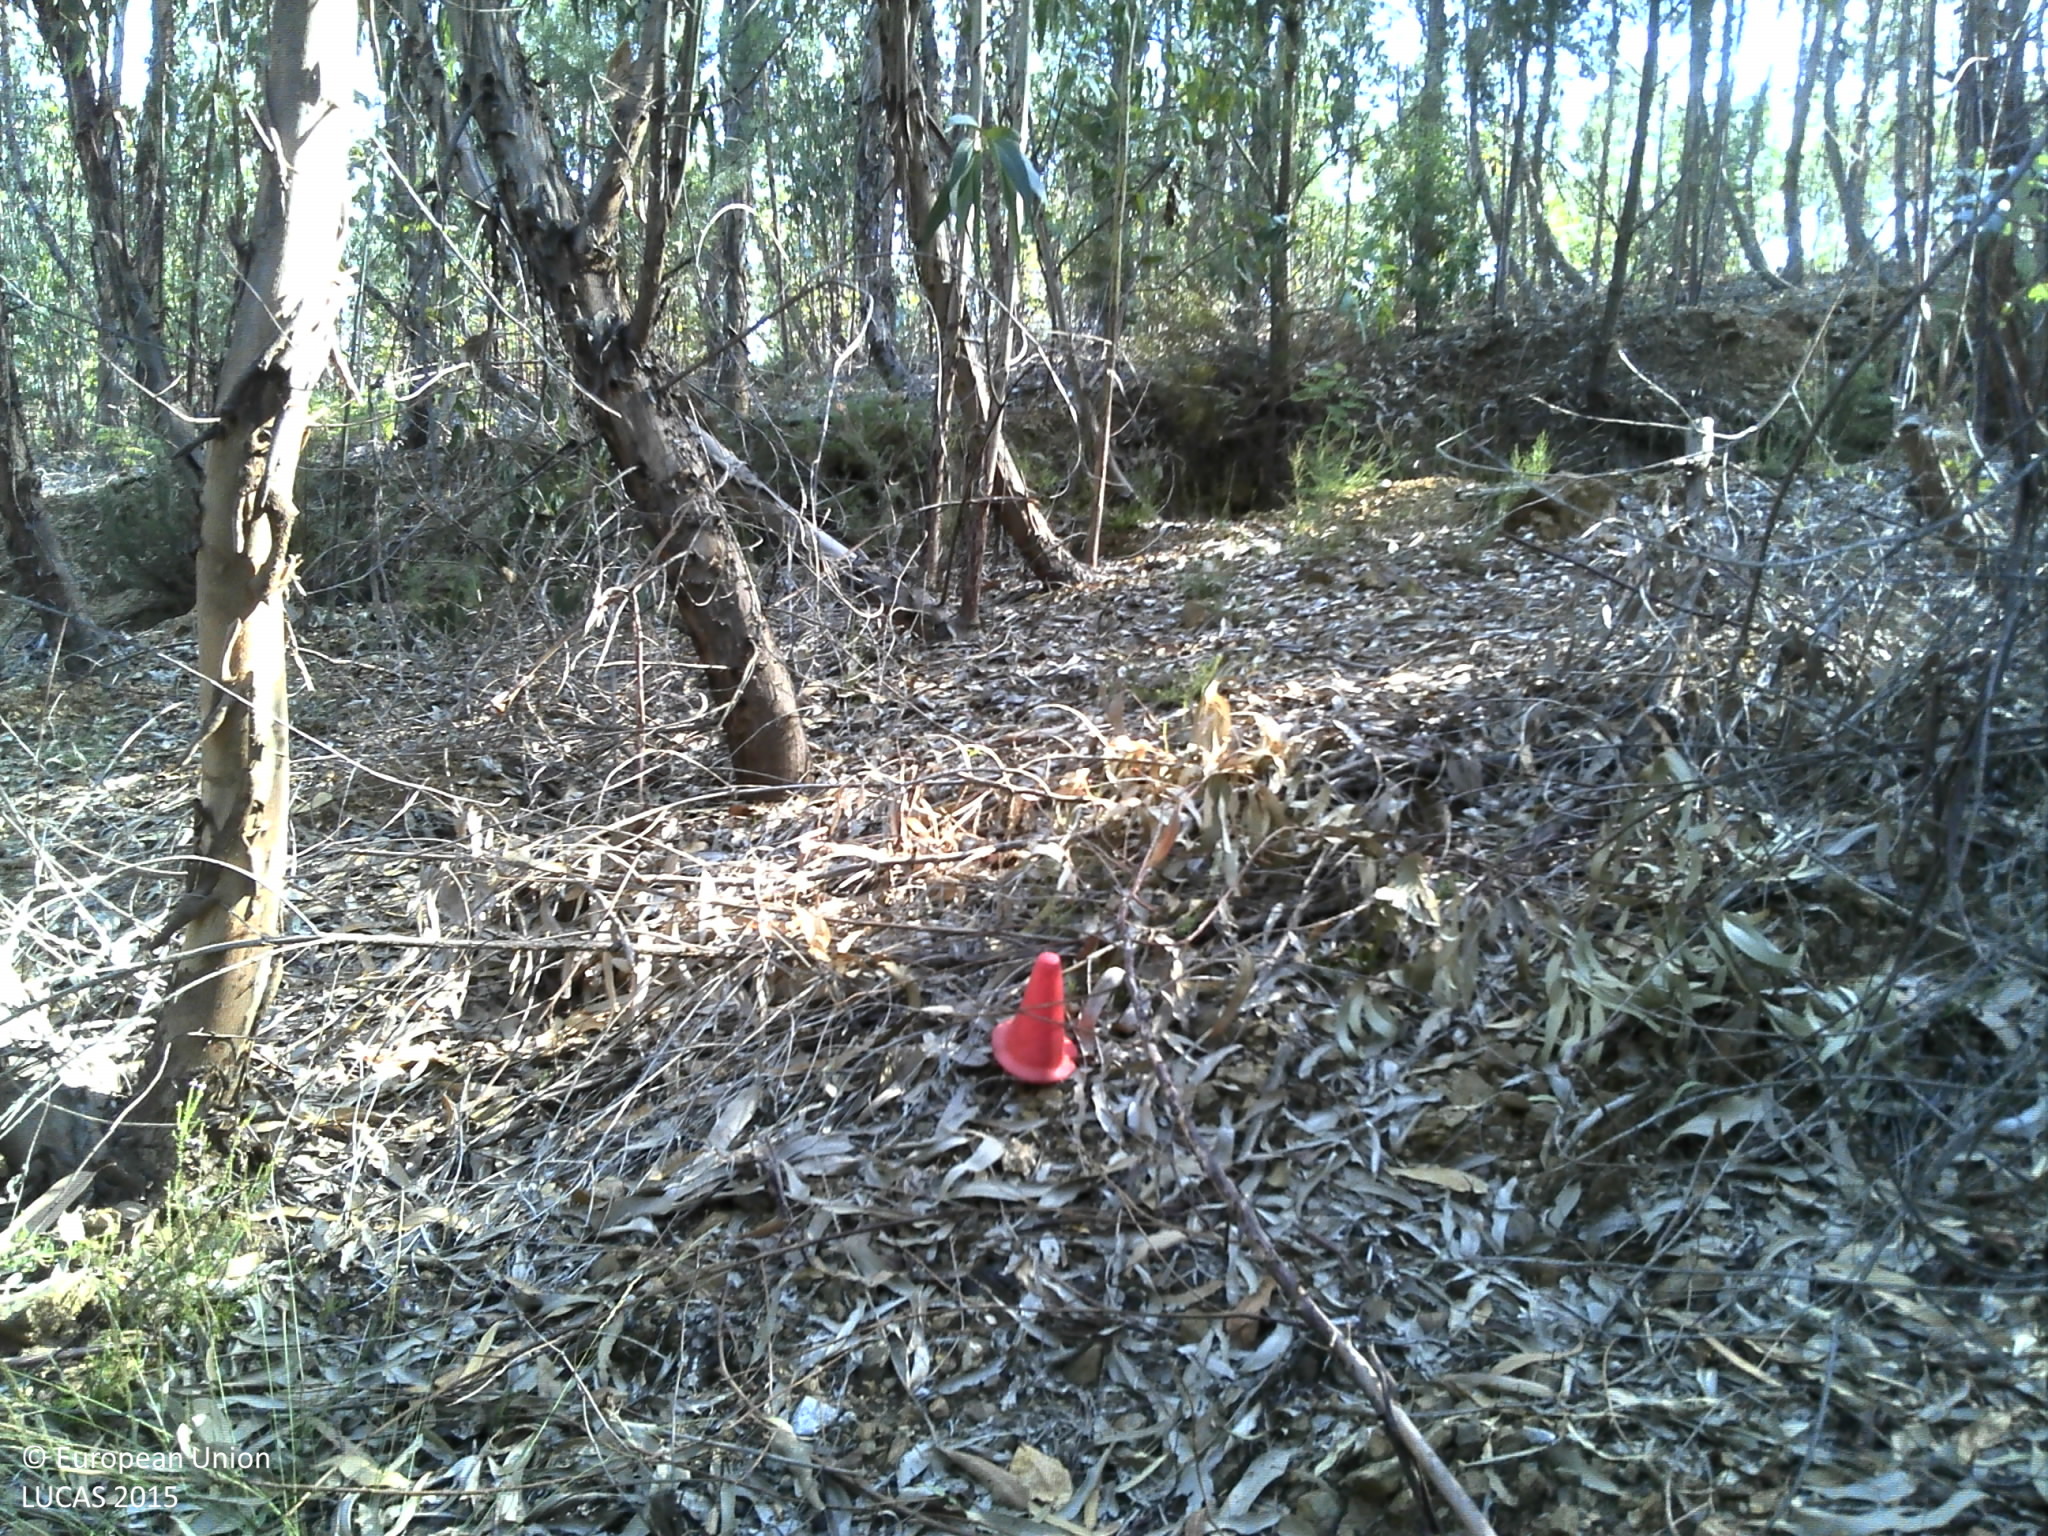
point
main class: Woodland
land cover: Broadleaved woodland
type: exotic forest
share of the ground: 25 - 50 %
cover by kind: unconsolidated bare surface 65 %, broadleaved forest trees 30 %, shrubs 5 %
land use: Forestry
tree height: > 5 m
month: June
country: PT
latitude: 39.9835
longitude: -8.1409
